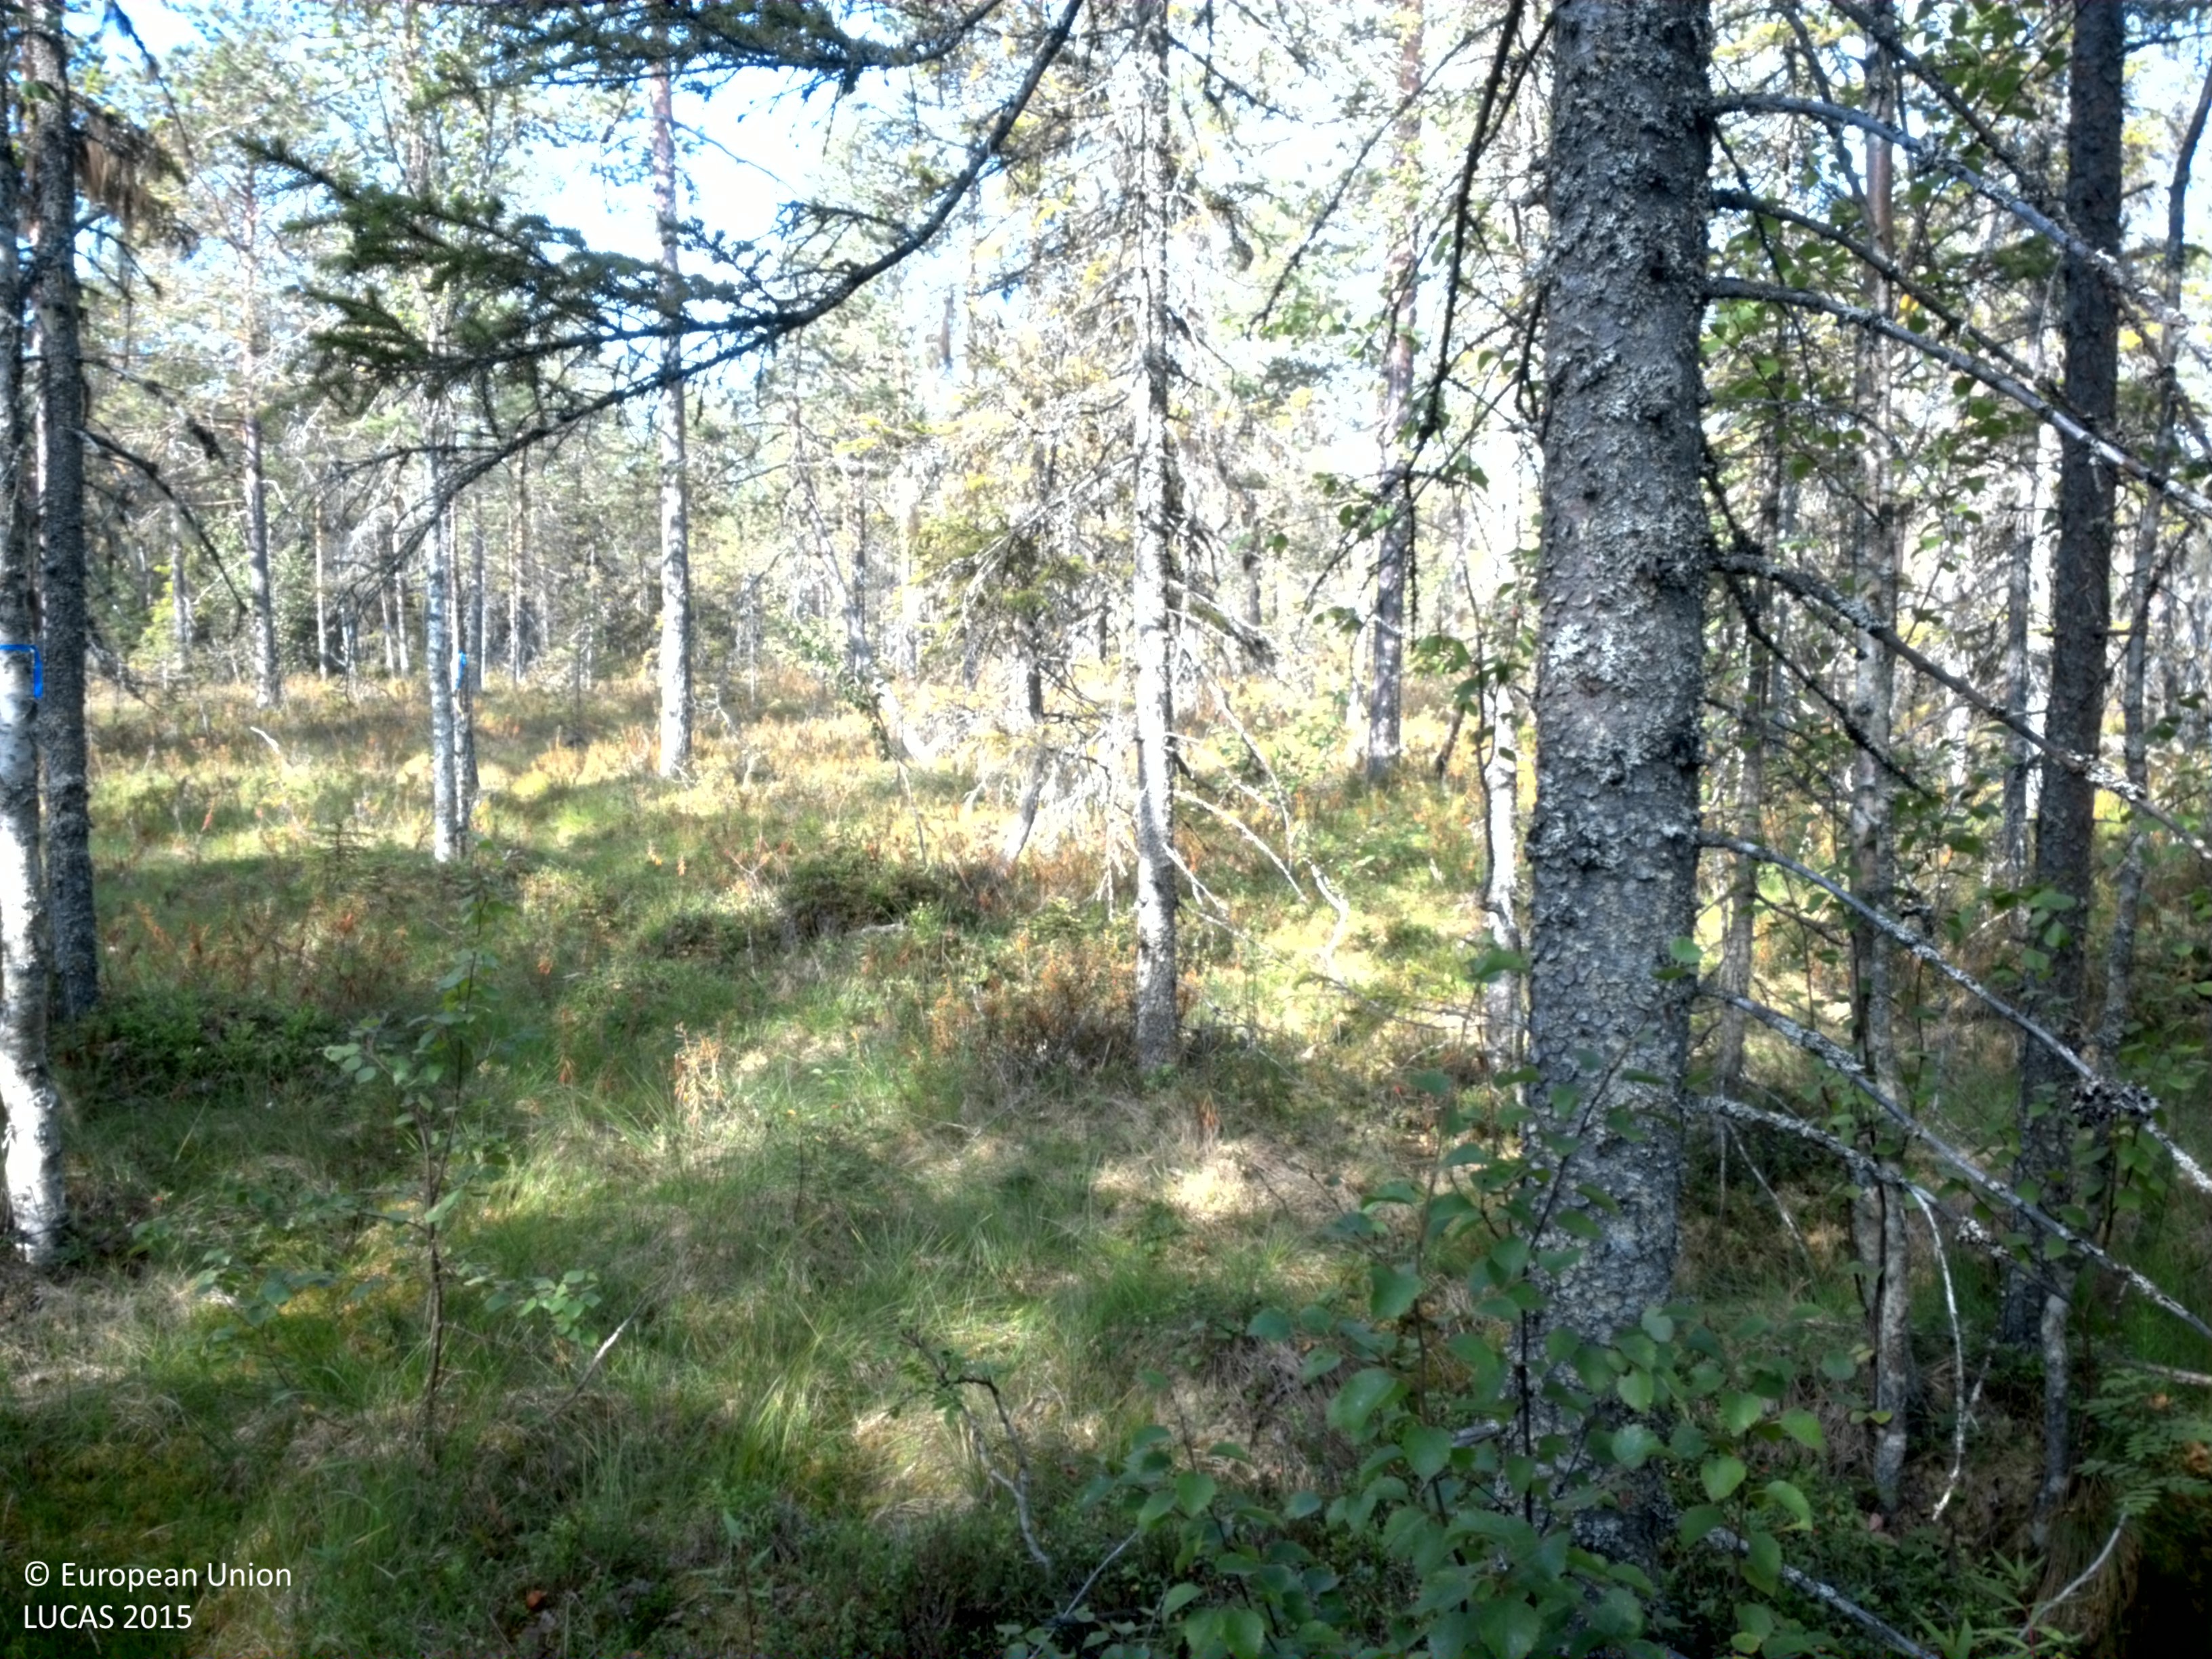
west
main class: Woodland
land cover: Spruce dominated mixed woodland
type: boreal forest
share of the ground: 50 - 75 %
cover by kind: coniferous forest trees 45 %, herbaceous plants 20 %, broadleaved forest trees 15 %, shrubs 10 %, lichens and mosses 10 %
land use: Semi-natural and natural areas not in use
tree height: > 5 m
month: August
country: SE
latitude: 64.3374
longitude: 18.7660
